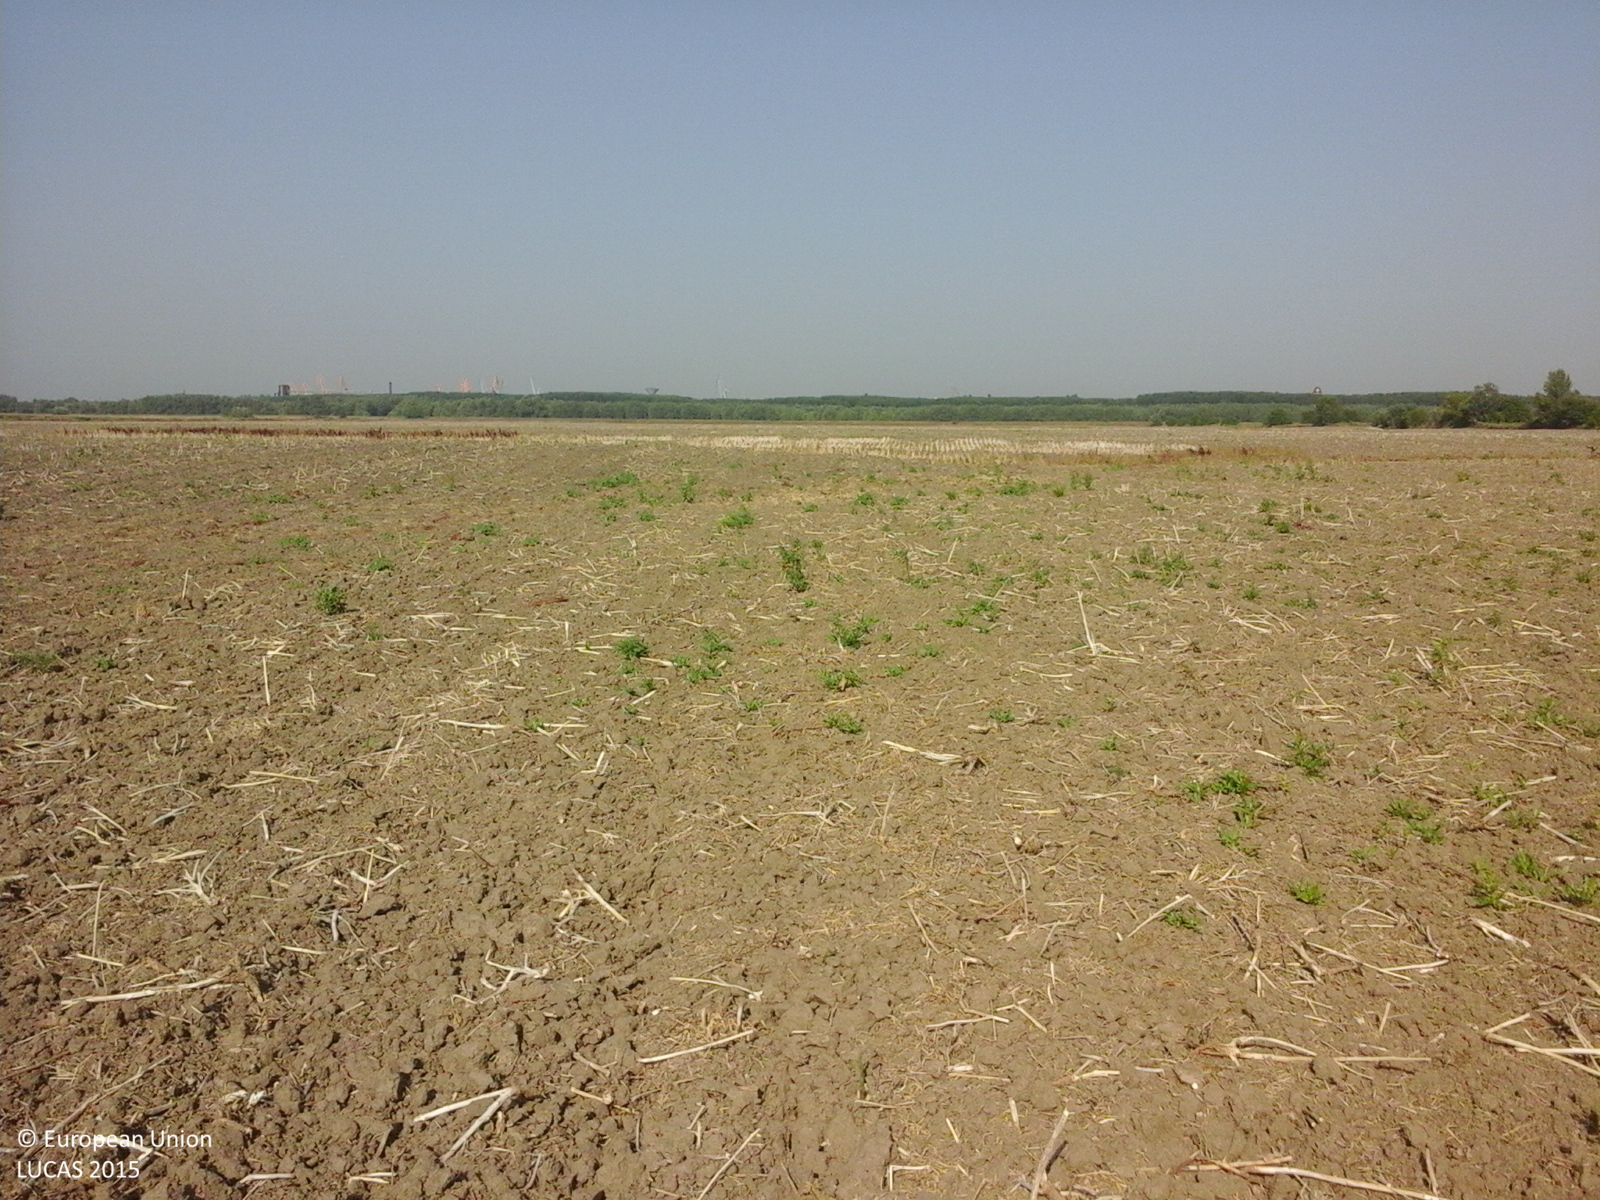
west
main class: Cropland
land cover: Rape and turnip rape
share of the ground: < 10 %
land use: Agriculture (excluding fallow land and kitchen gardens)
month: August
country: RO
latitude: 45.2517
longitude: 27.9917
